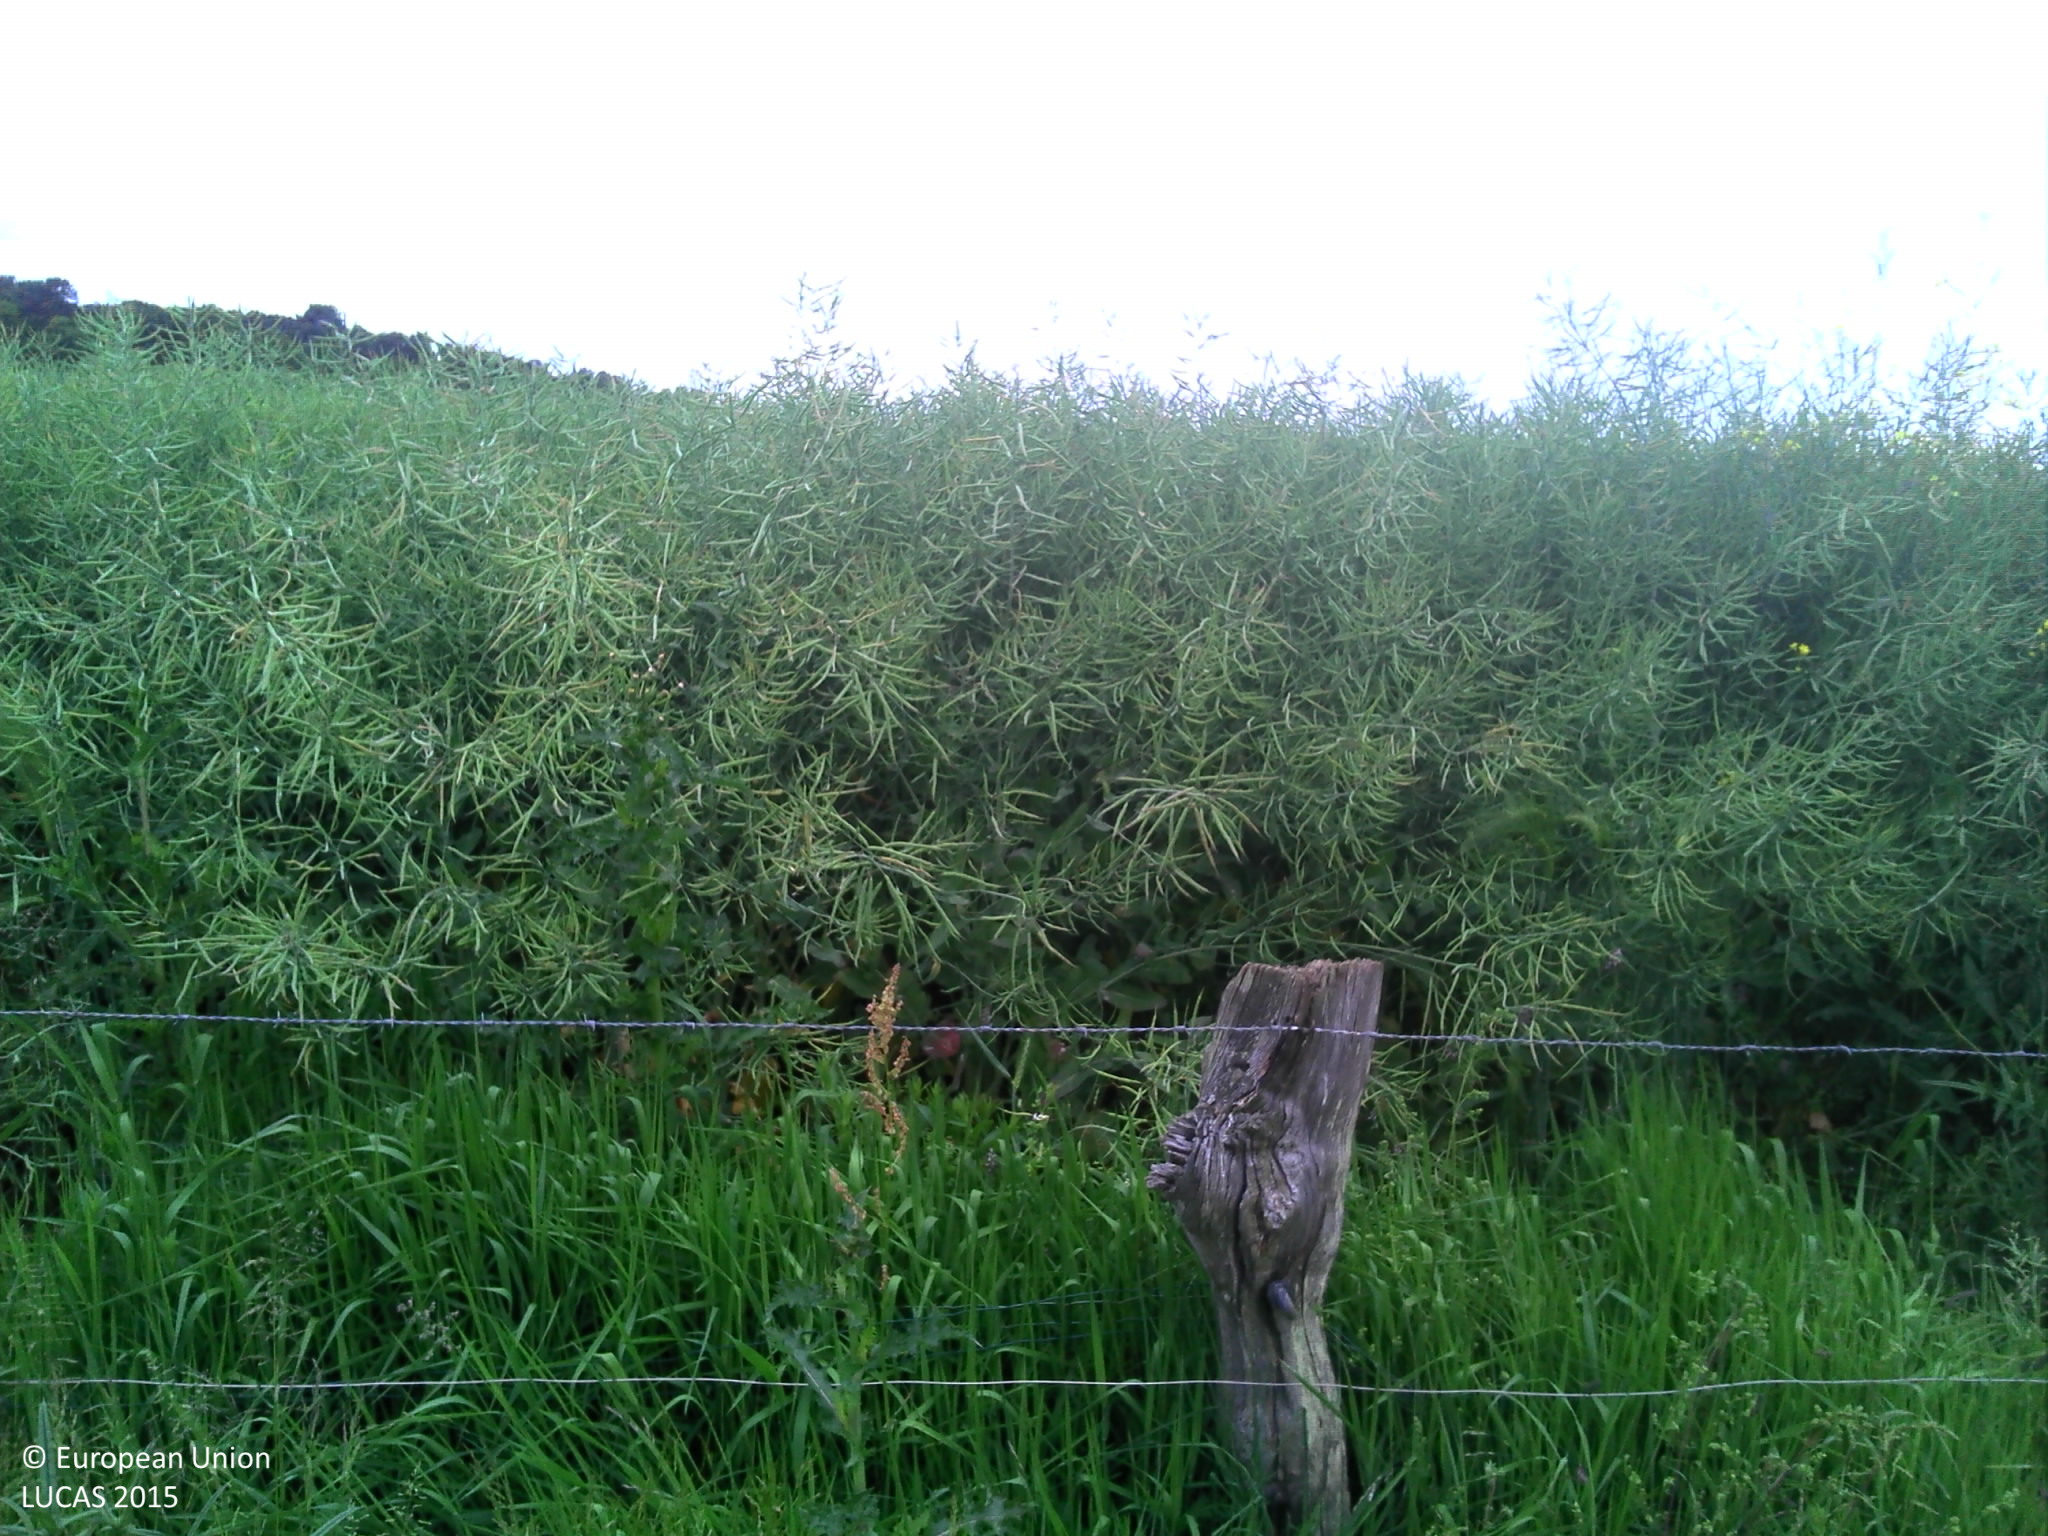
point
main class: Cropland
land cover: Rape and turnip rape
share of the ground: > 75 %
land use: Agriculture (excluding fallow land and kitchen gardens)
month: May
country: FR
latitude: 48.2263
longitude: -0.1397
